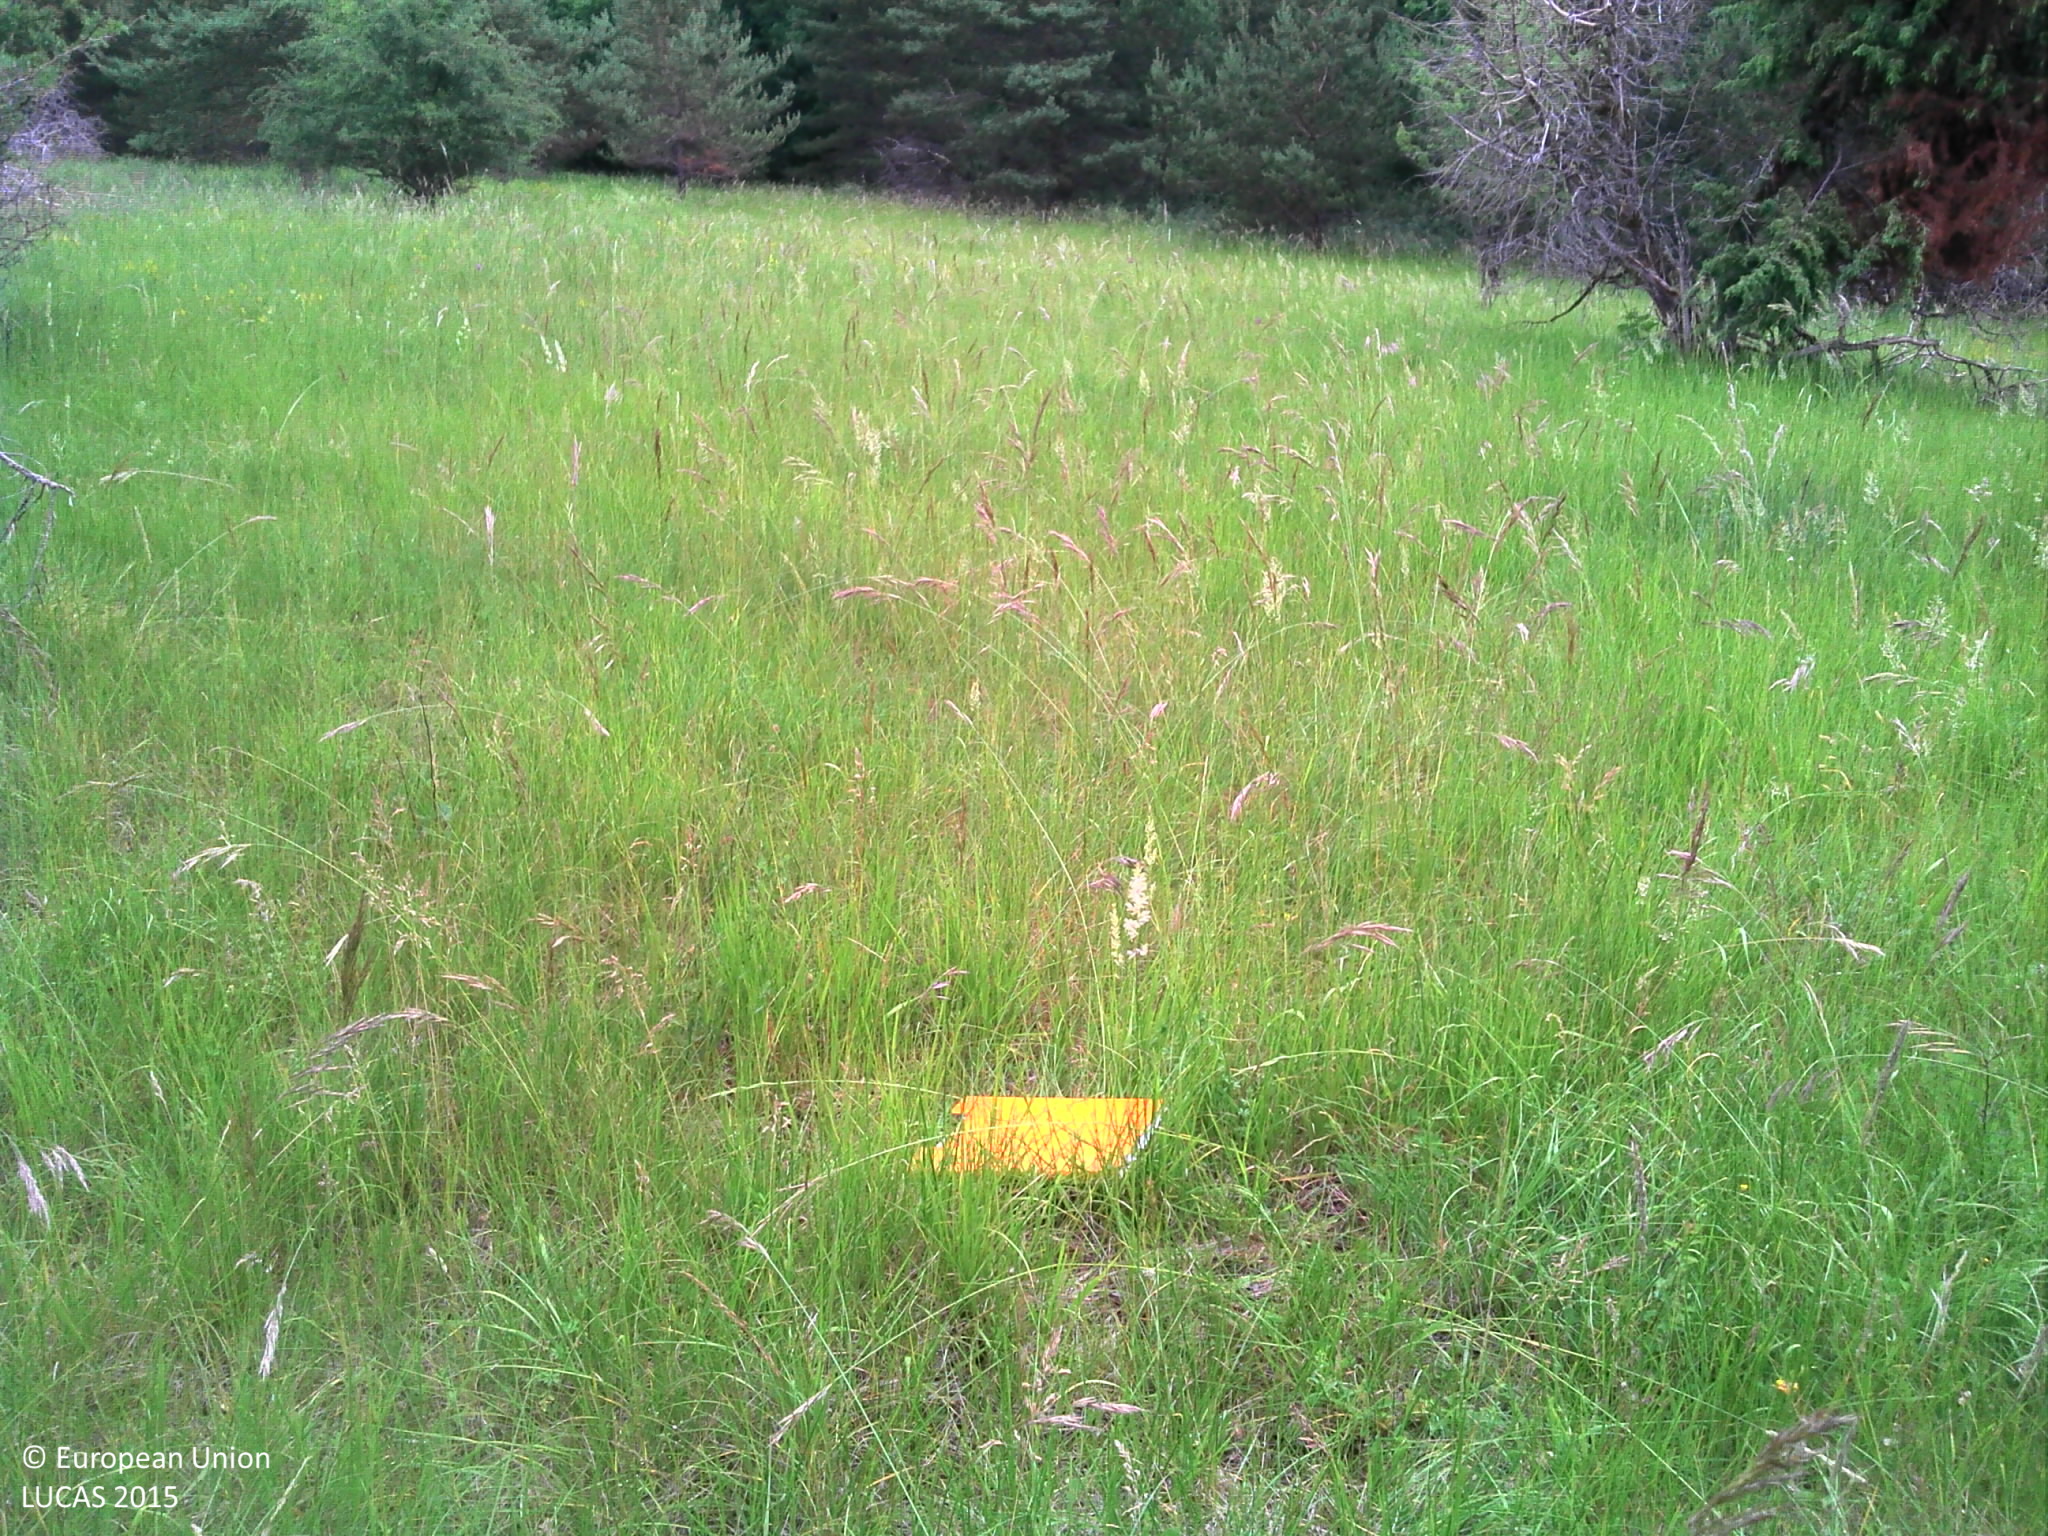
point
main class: Grassland
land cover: Grassland with sparse tree/shrub cover
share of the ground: > 75 %
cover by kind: herbaceous plants 85 %, shrubs 10 %, broadleaved forest trees 5 %
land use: Agriculture (excluding fallow land and kitchen gardens)
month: June
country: FR
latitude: 48.3646
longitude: 5.0450
